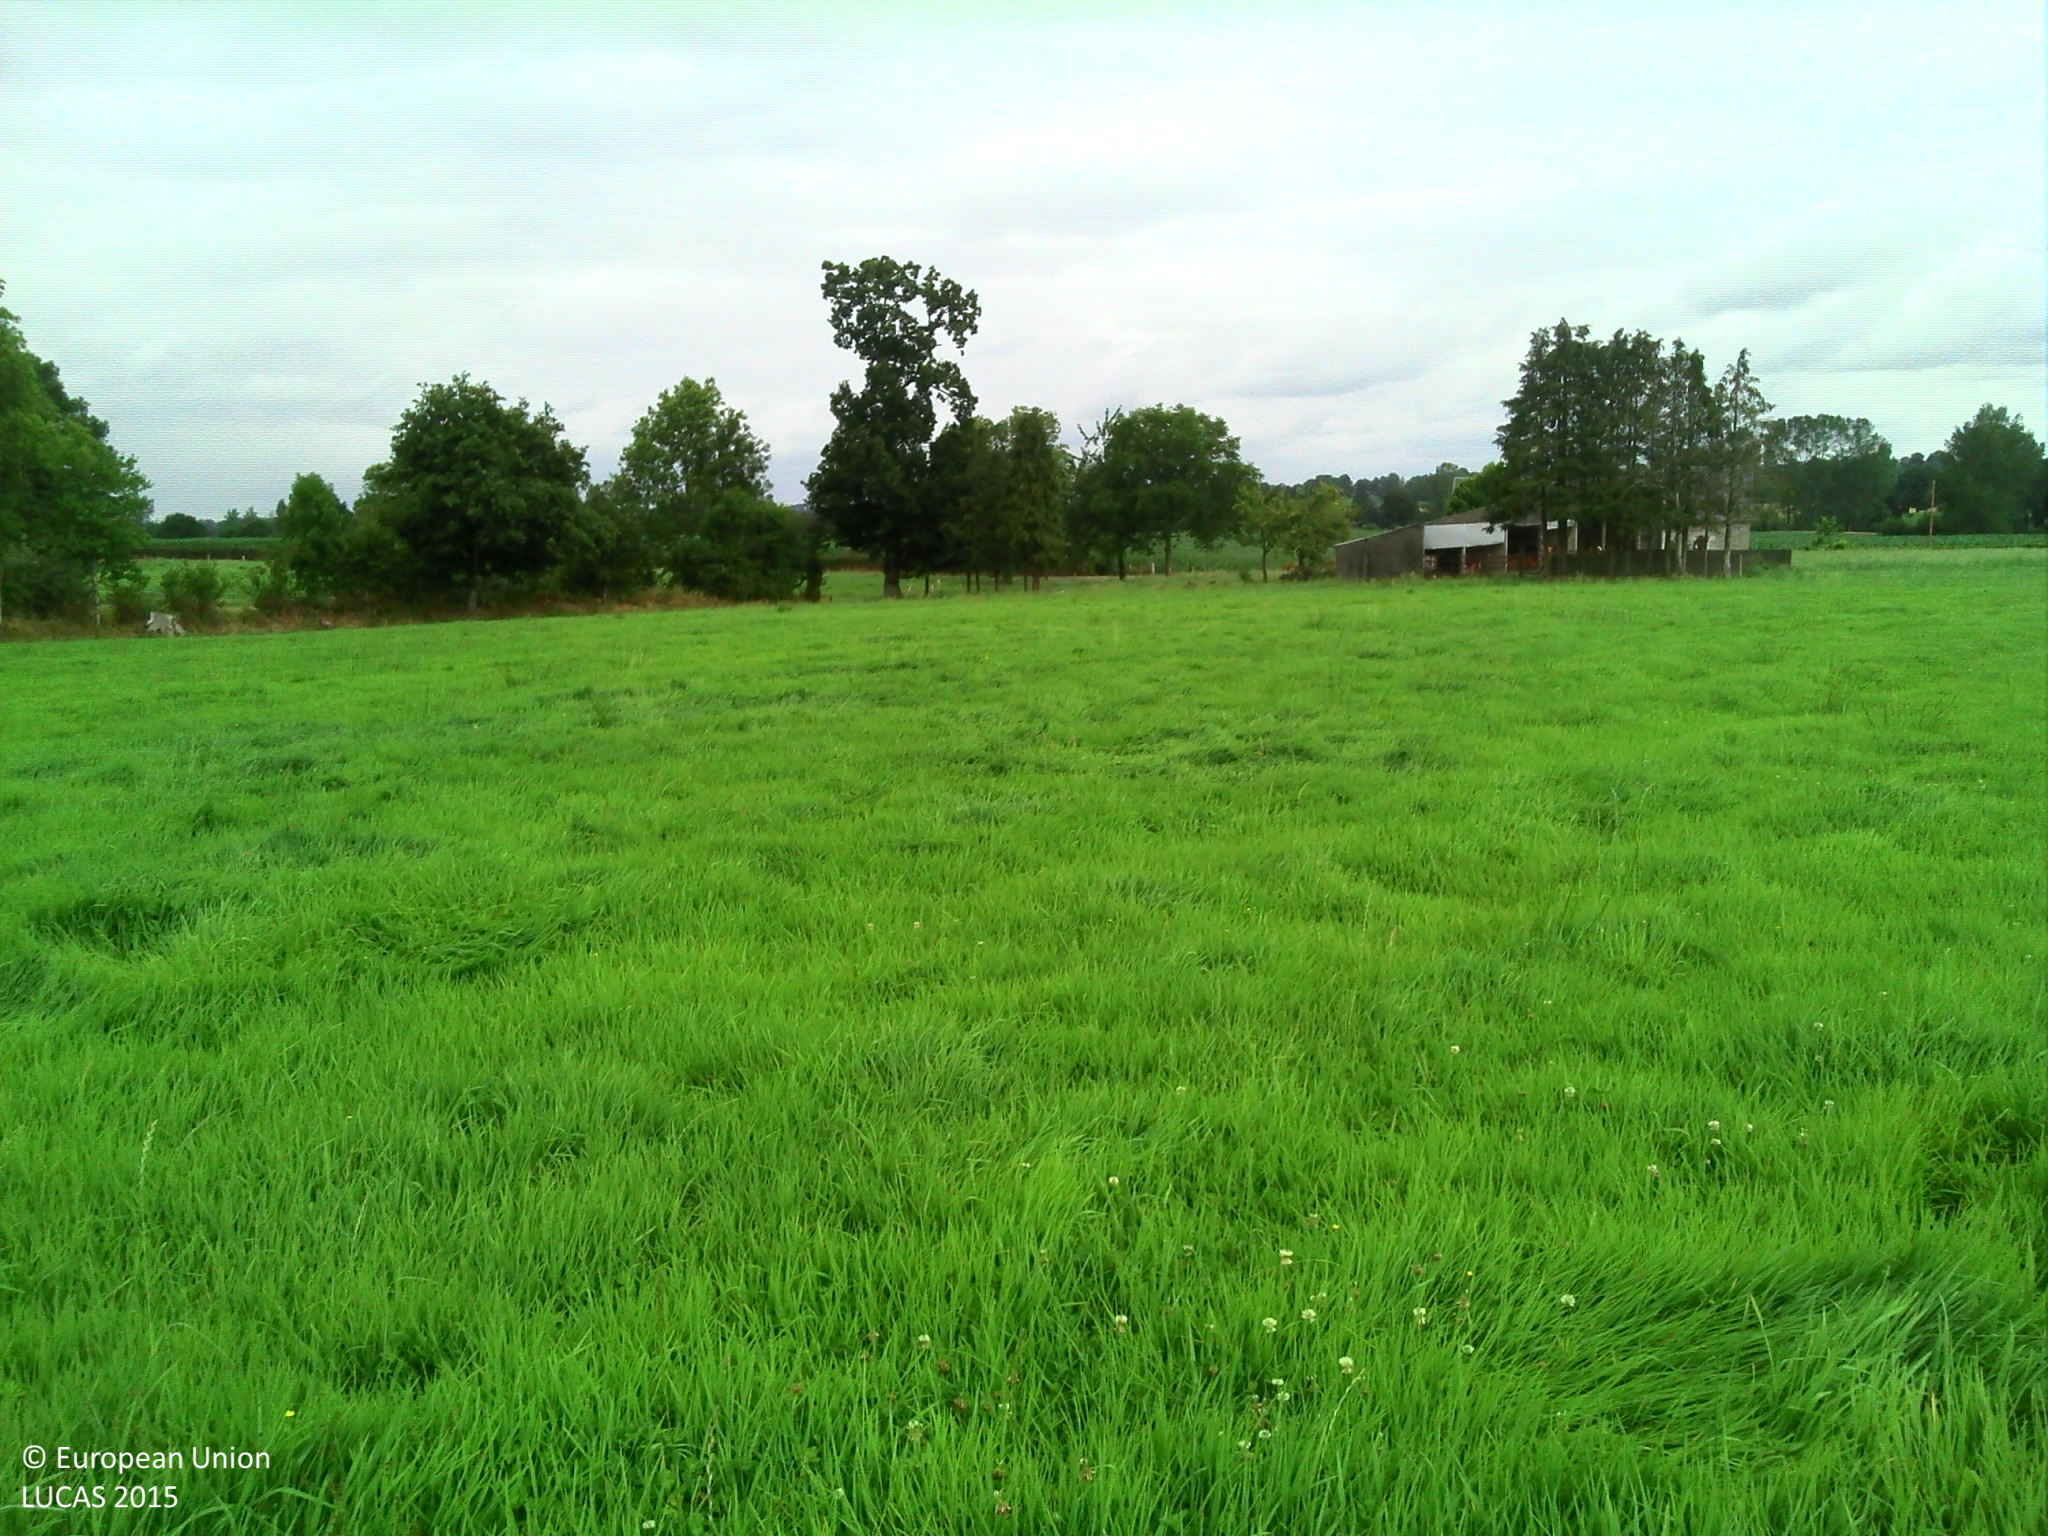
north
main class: Grassland
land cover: Grassland without tree/shrub cover
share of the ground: > 75 %
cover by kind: herbaceous plants 100 %
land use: Agriculture (excluding fallow land and kitchen gardens)
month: July
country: FR
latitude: 48.8614
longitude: -1.2632
